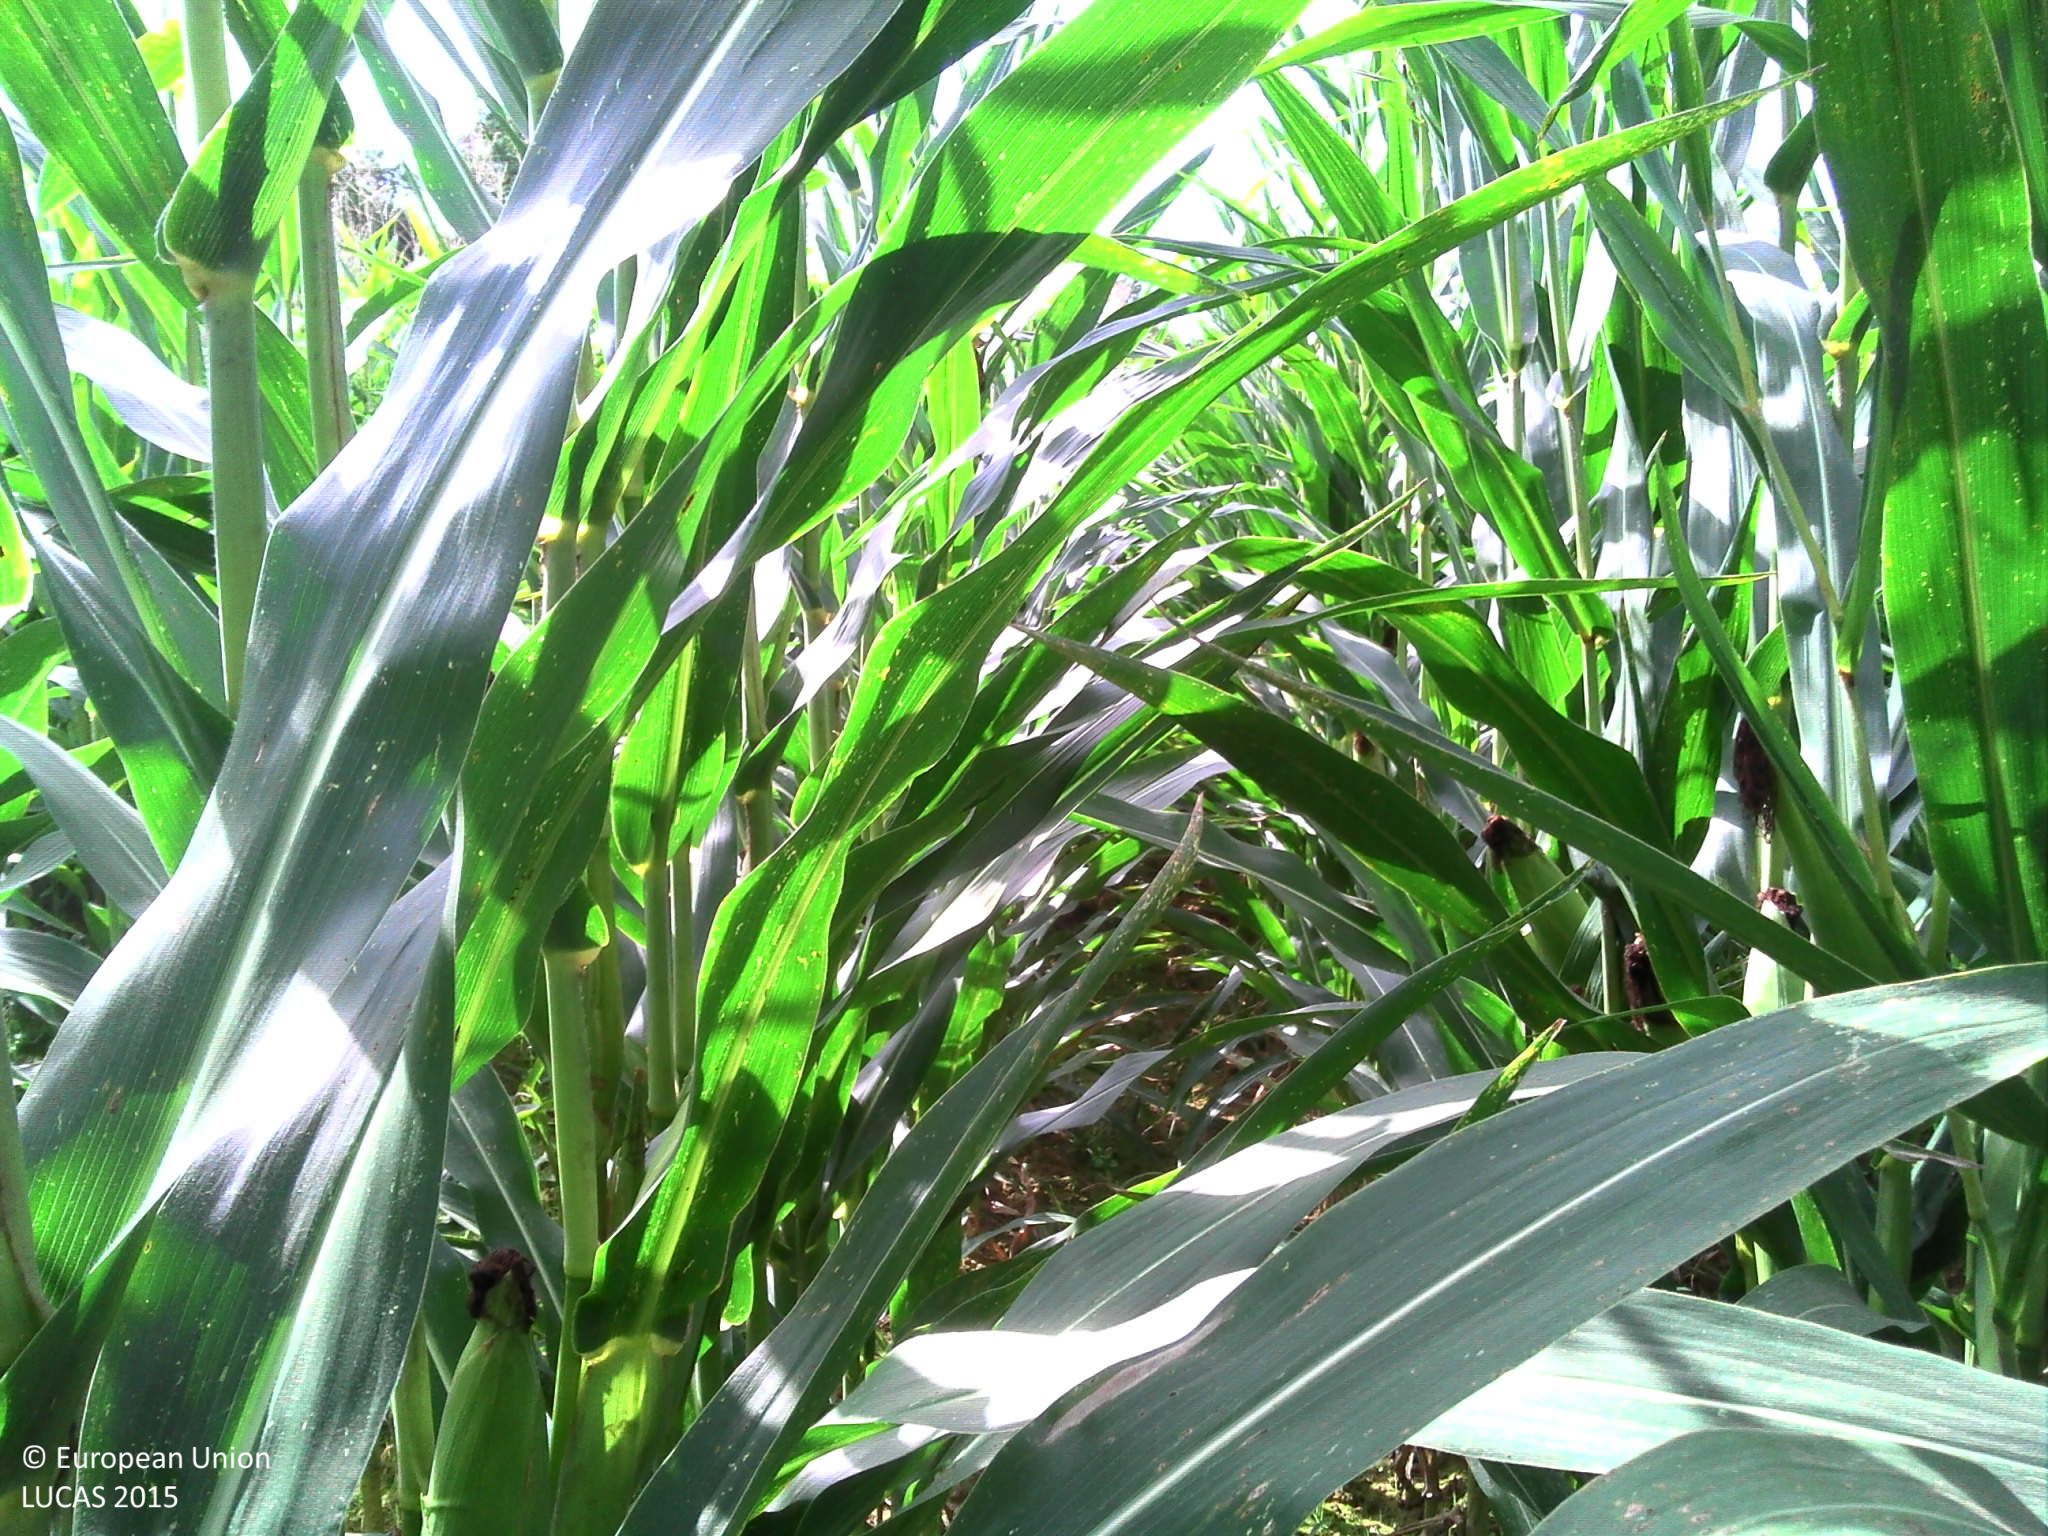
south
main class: Cropland
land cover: Maize
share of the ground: > 75 %
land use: Agriculture (excluding fallow land and kitchen gardens)
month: September
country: FR
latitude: 43.5743
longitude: -0.1983
